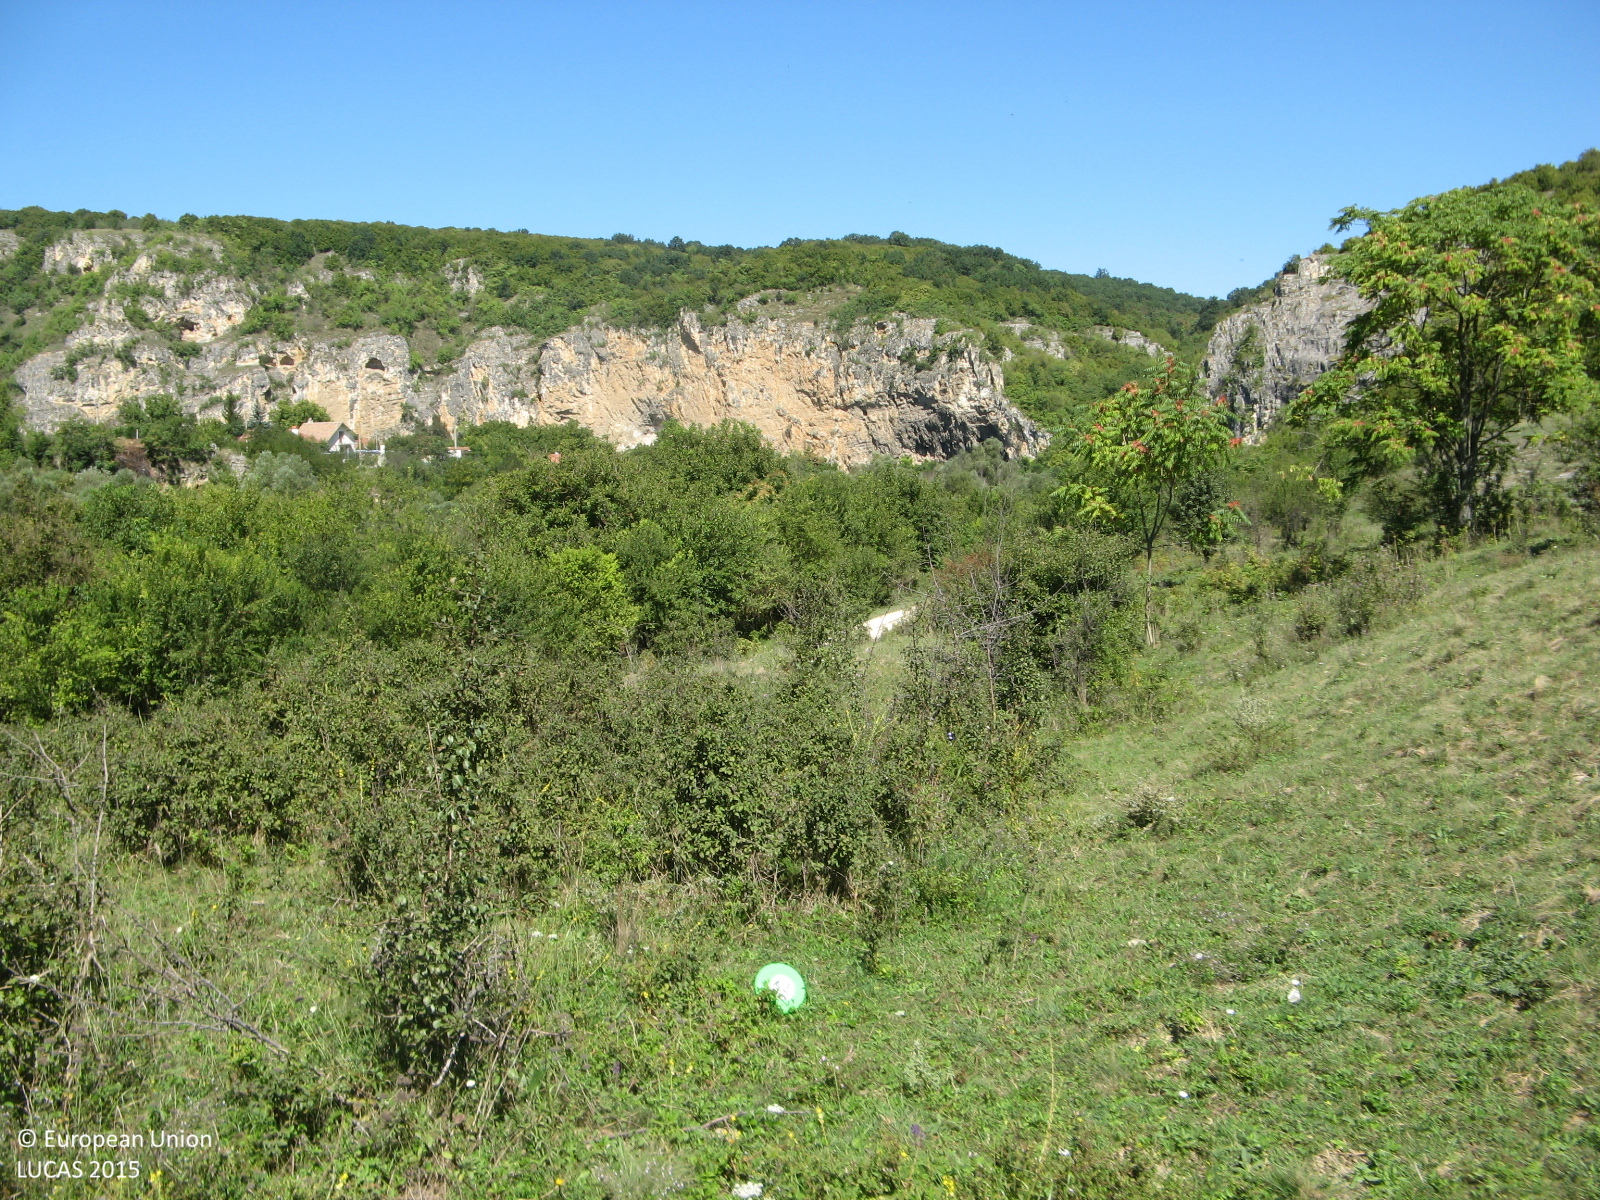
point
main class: Grassland
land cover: Grassland with sparse tree/shrub cover
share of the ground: > 75 %
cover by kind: herbaceous plants 90 %, broadleaved forest trees 5 %, shrubs 5 %
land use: Agriculture (excluding fallow land and kitchen gardens)
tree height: < 5 m
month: September
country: BG
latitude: 43.6560
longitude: 26.0792
